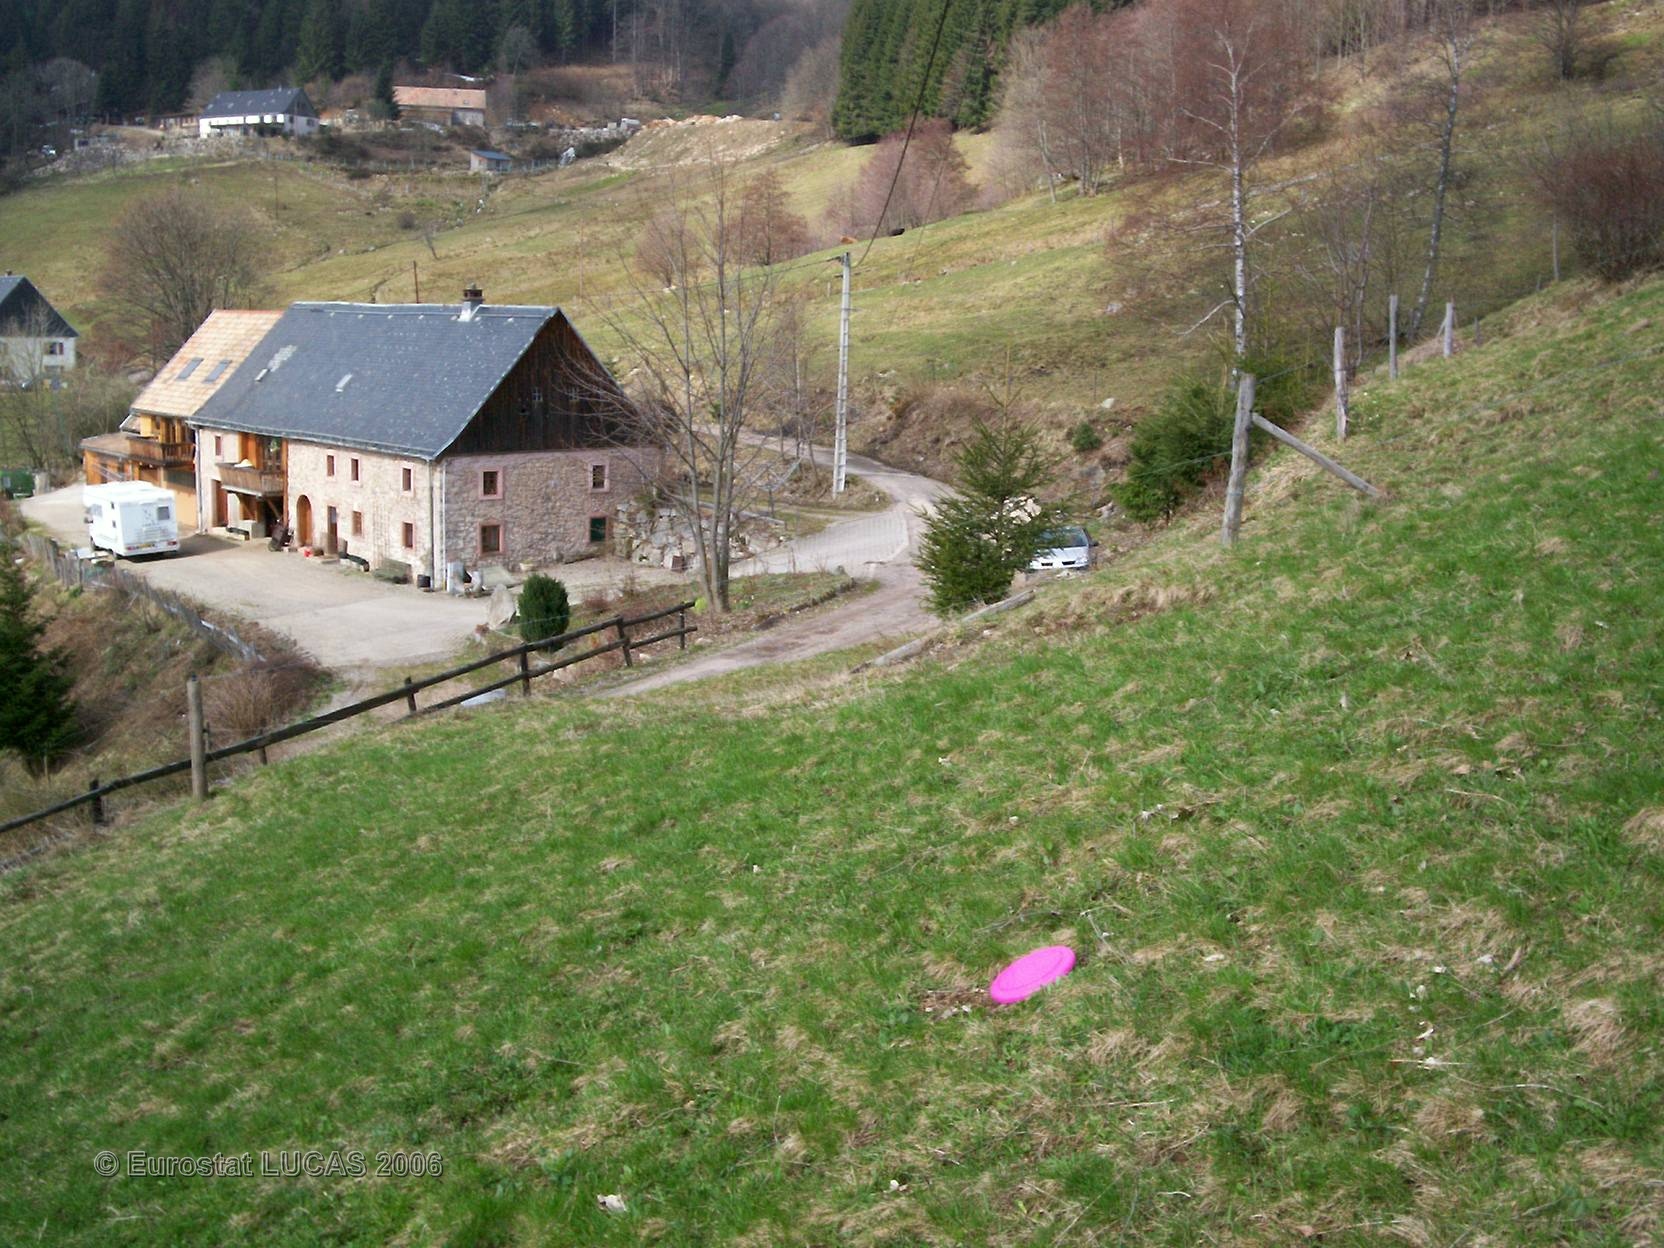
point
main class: Grassland
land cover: Grassland without tree/shrub cover
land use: Agriculture (excluding fallow land and kitchen gardens)
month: April
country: FR
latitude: 48.1317
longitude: 7.1122
